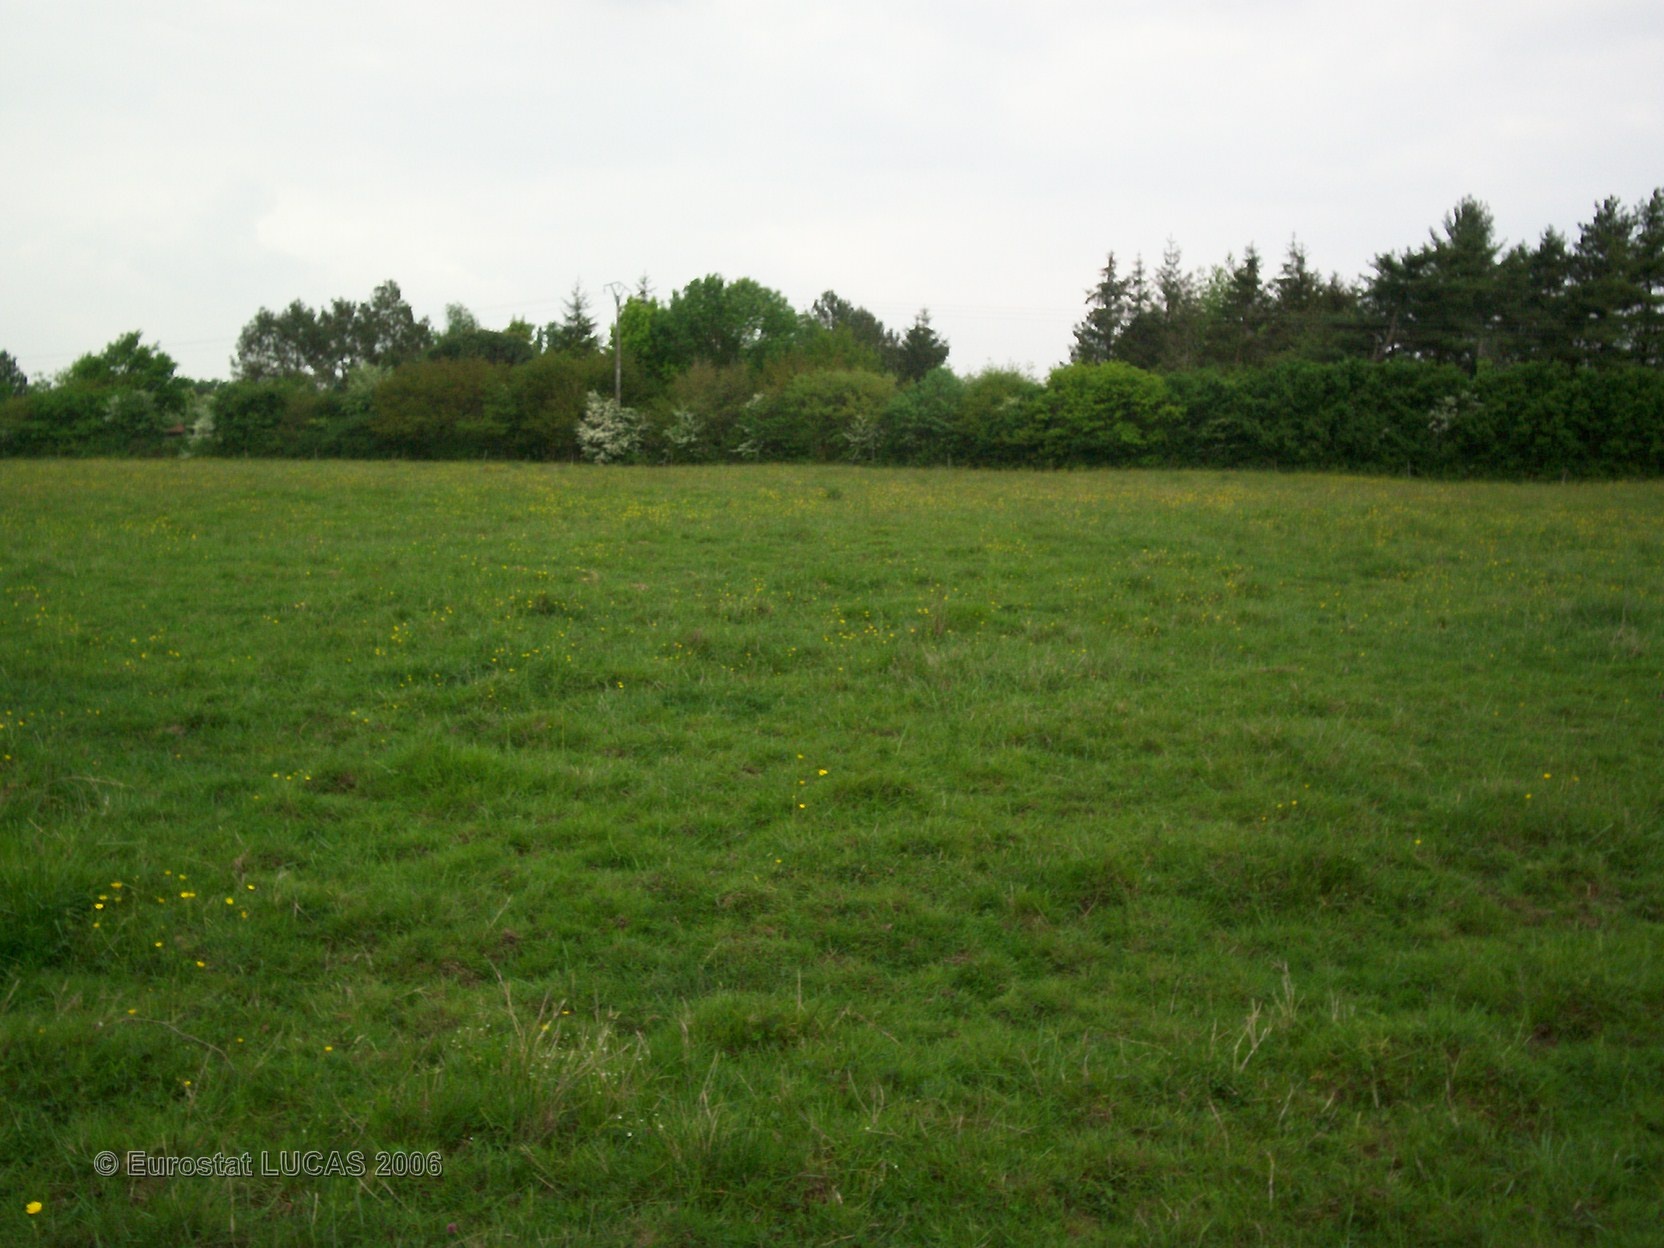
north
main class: Grassland
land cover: Grassland without tree/shrub cover
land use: Agriculture (excluding fallow land and kitchen gardens)
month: April
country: FR
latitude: 43.7147
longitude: -0.2482
